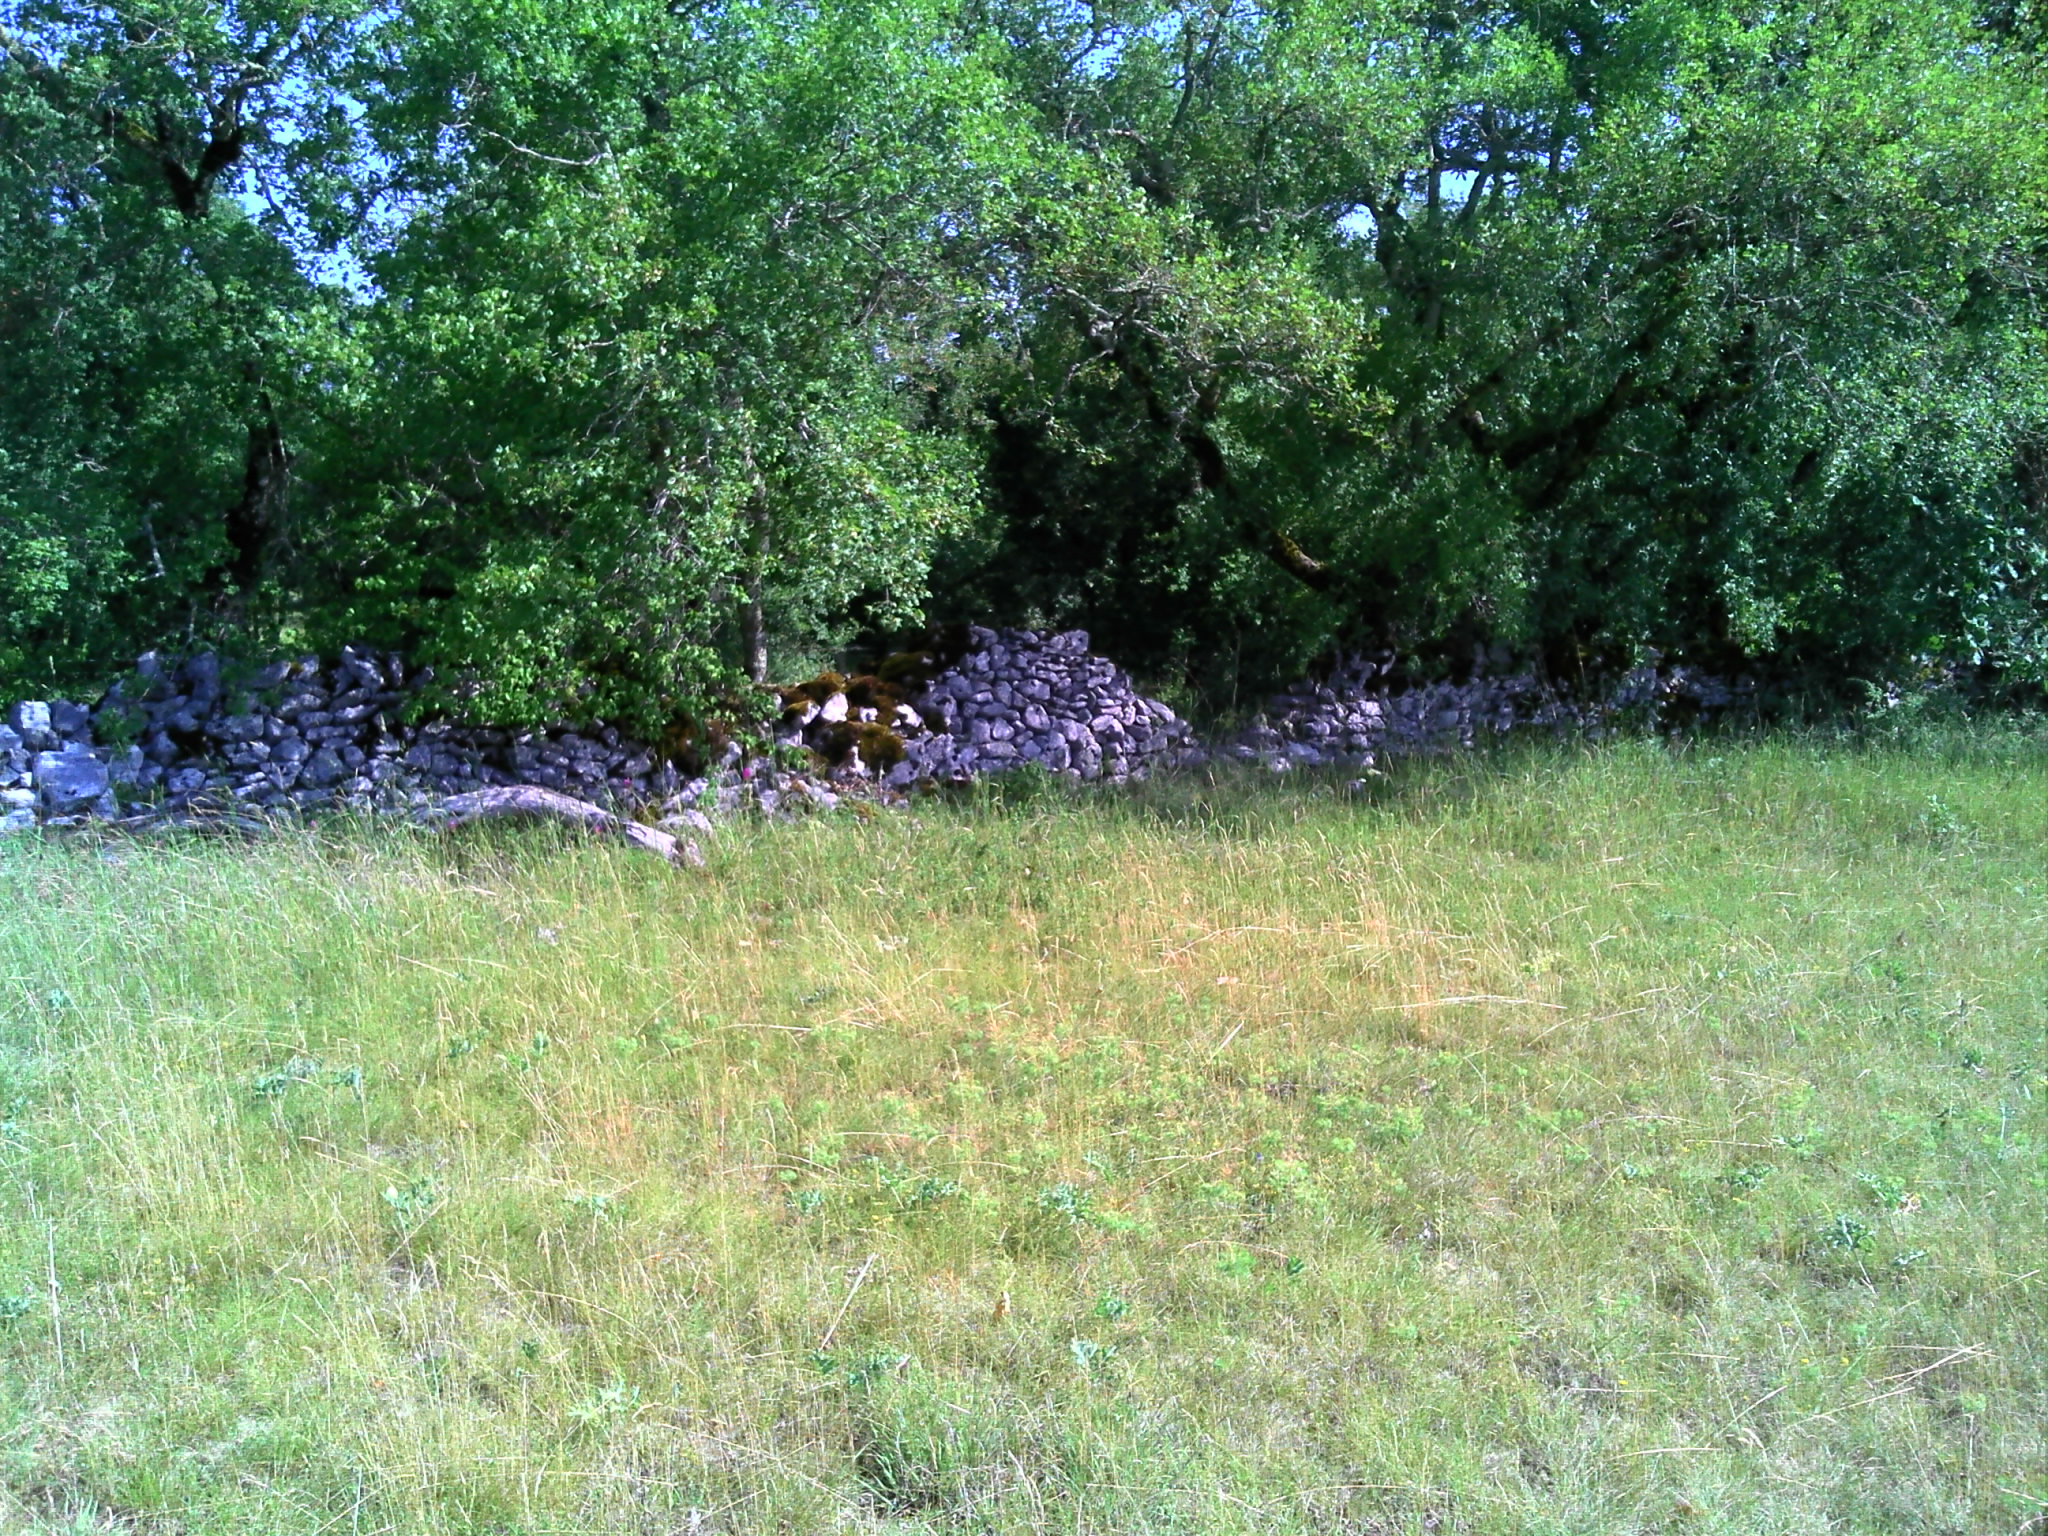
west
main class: Grassland
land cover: Grassland without tree/shrub cover
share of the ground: > 75 %
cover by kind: herbaceous plants 70 %, lichens and mosses 30 %
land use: Agriculture (excluding fallow land and kitchen gardens)
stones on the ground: 10 - 25 %
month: June
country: FR
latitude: 44.6589
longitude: 1.7889
